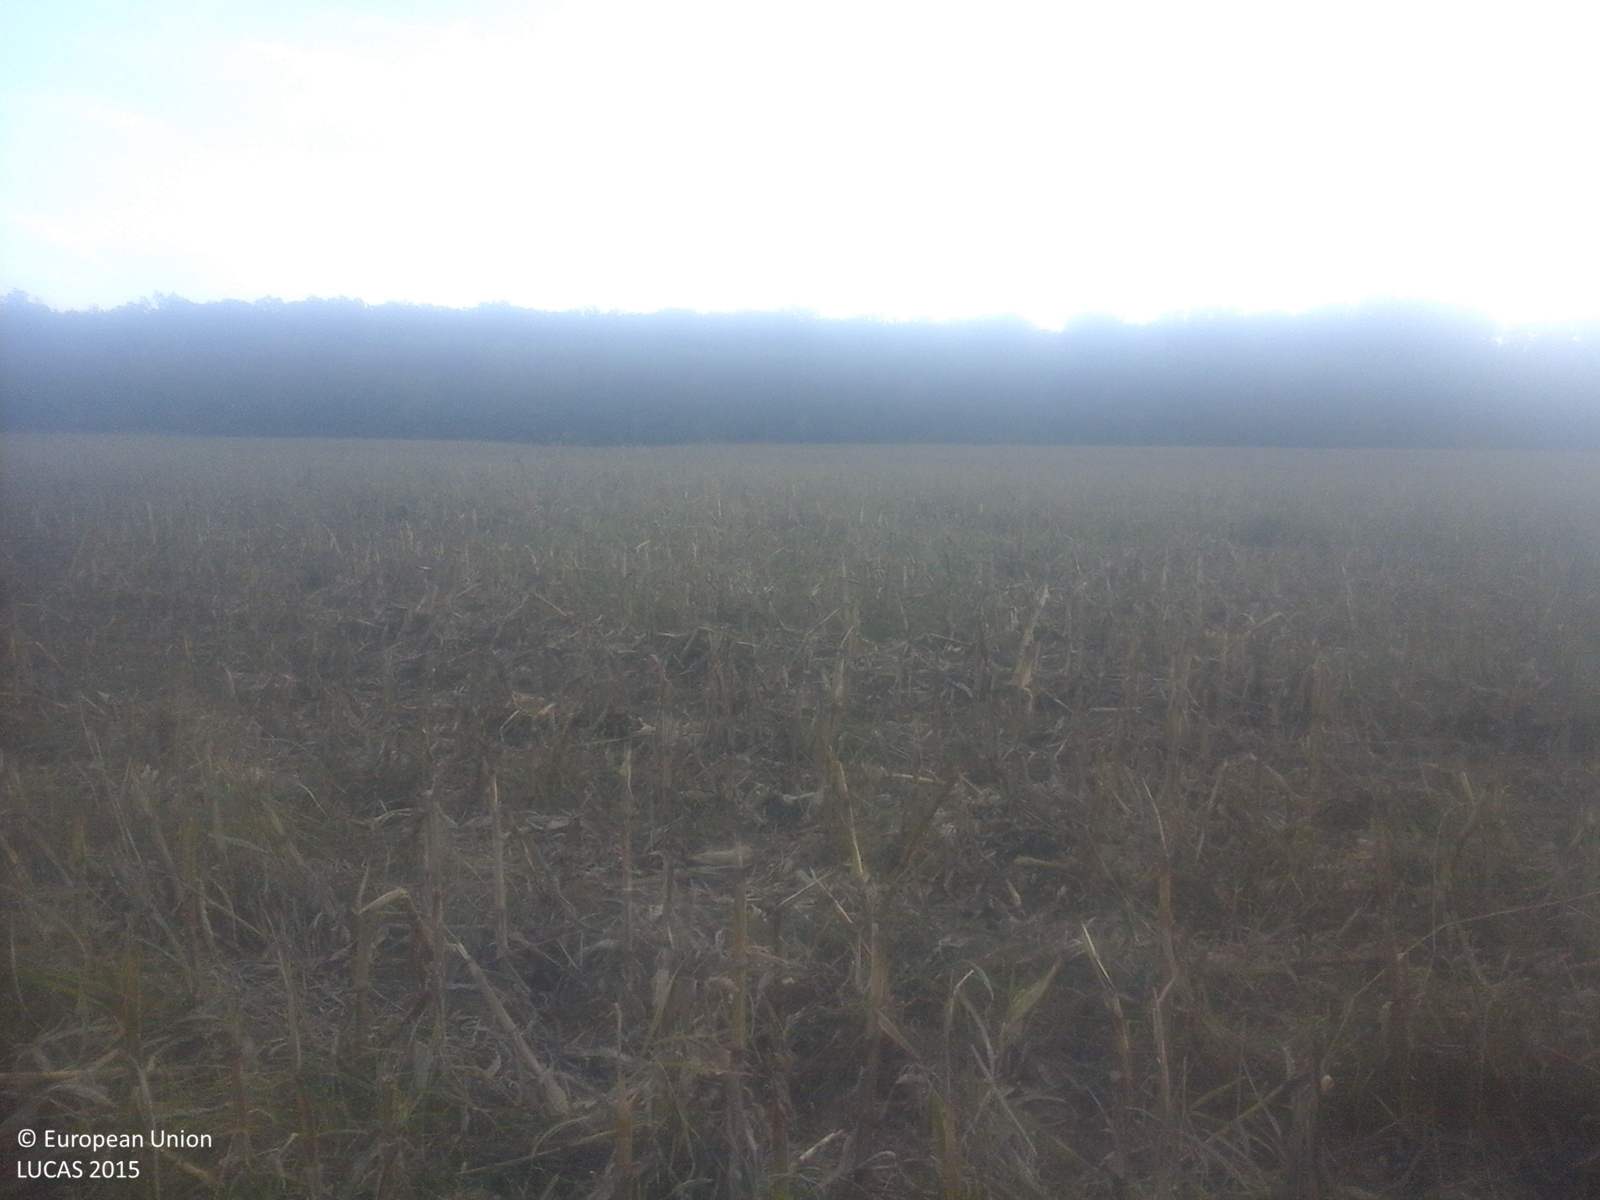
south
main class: Cropland
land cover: Maize
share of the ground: 25 - 50 %
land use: Agriculture (excluding fallow land and kitchen gardens)
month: October
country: RO
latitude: 44.7578
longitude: 25.9590
